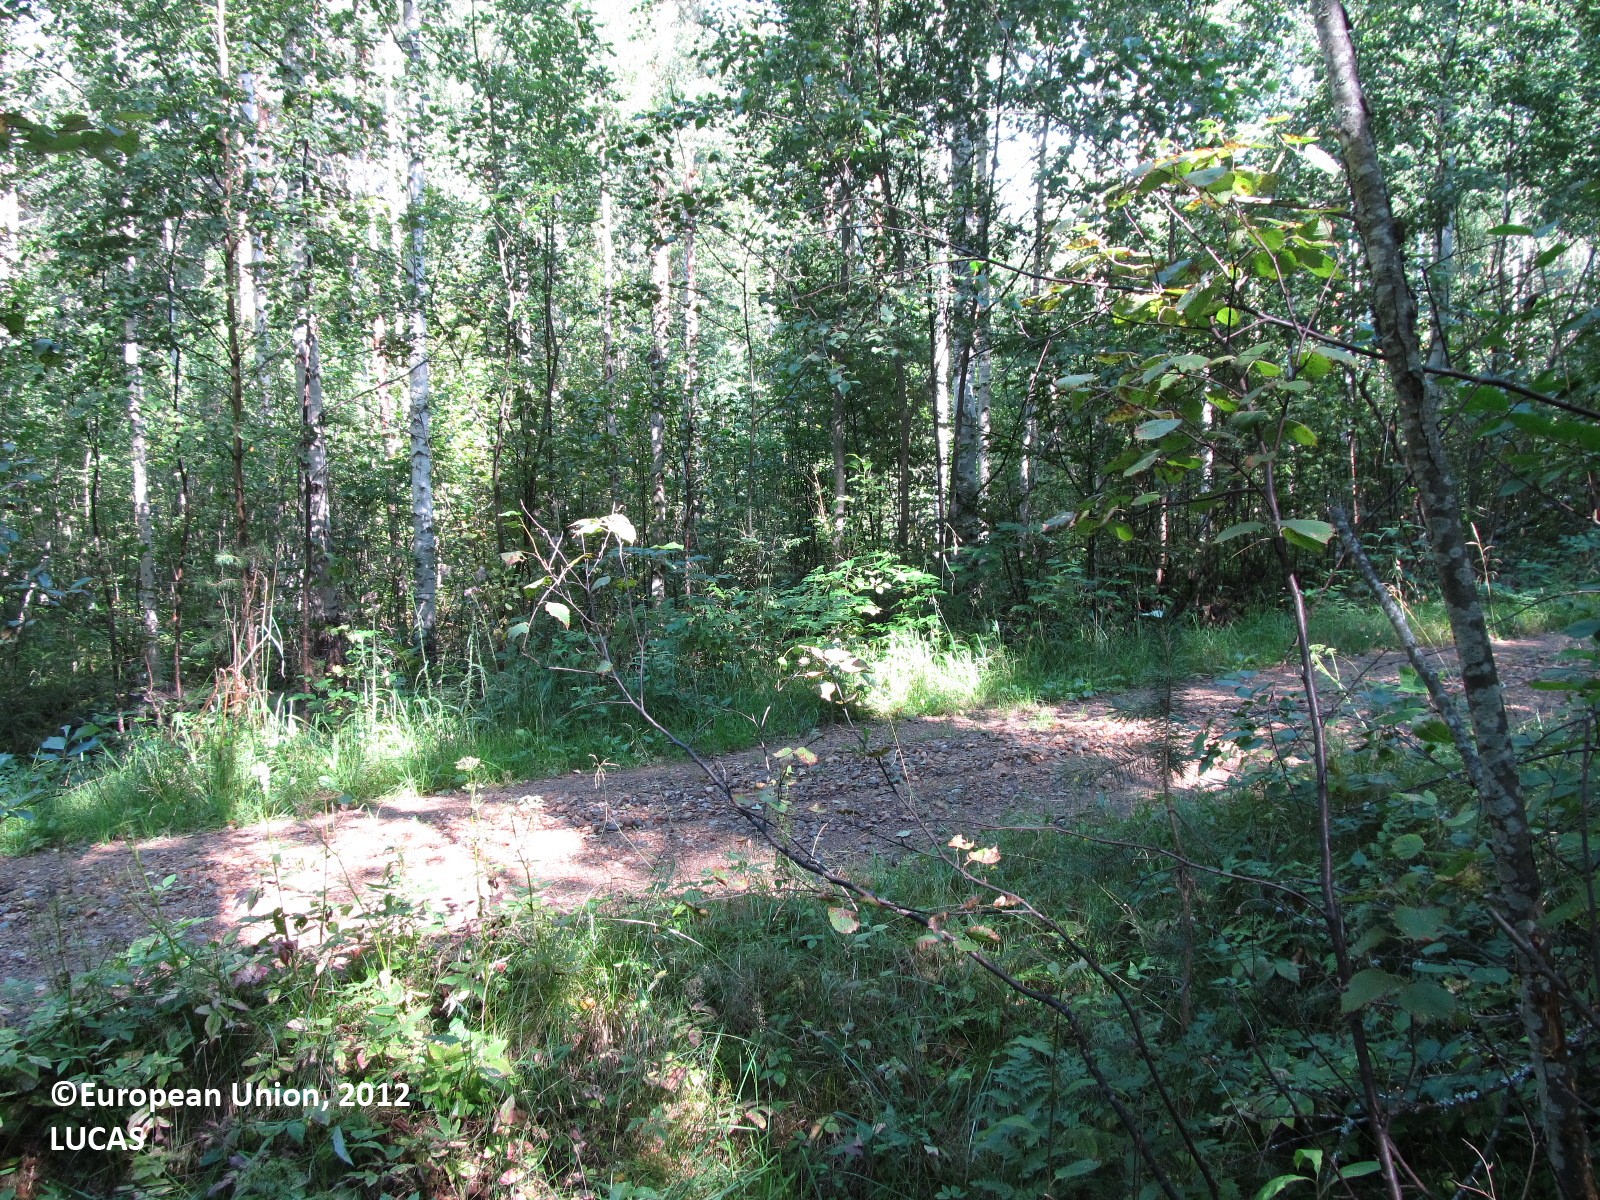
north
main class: Woodland
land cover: Broadleaved woodland
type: boreal forest
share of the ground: 50 - 75 %
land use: Forestry
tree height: > 5 m
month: August
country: FI
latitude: 62.1791
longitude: 28.4691
